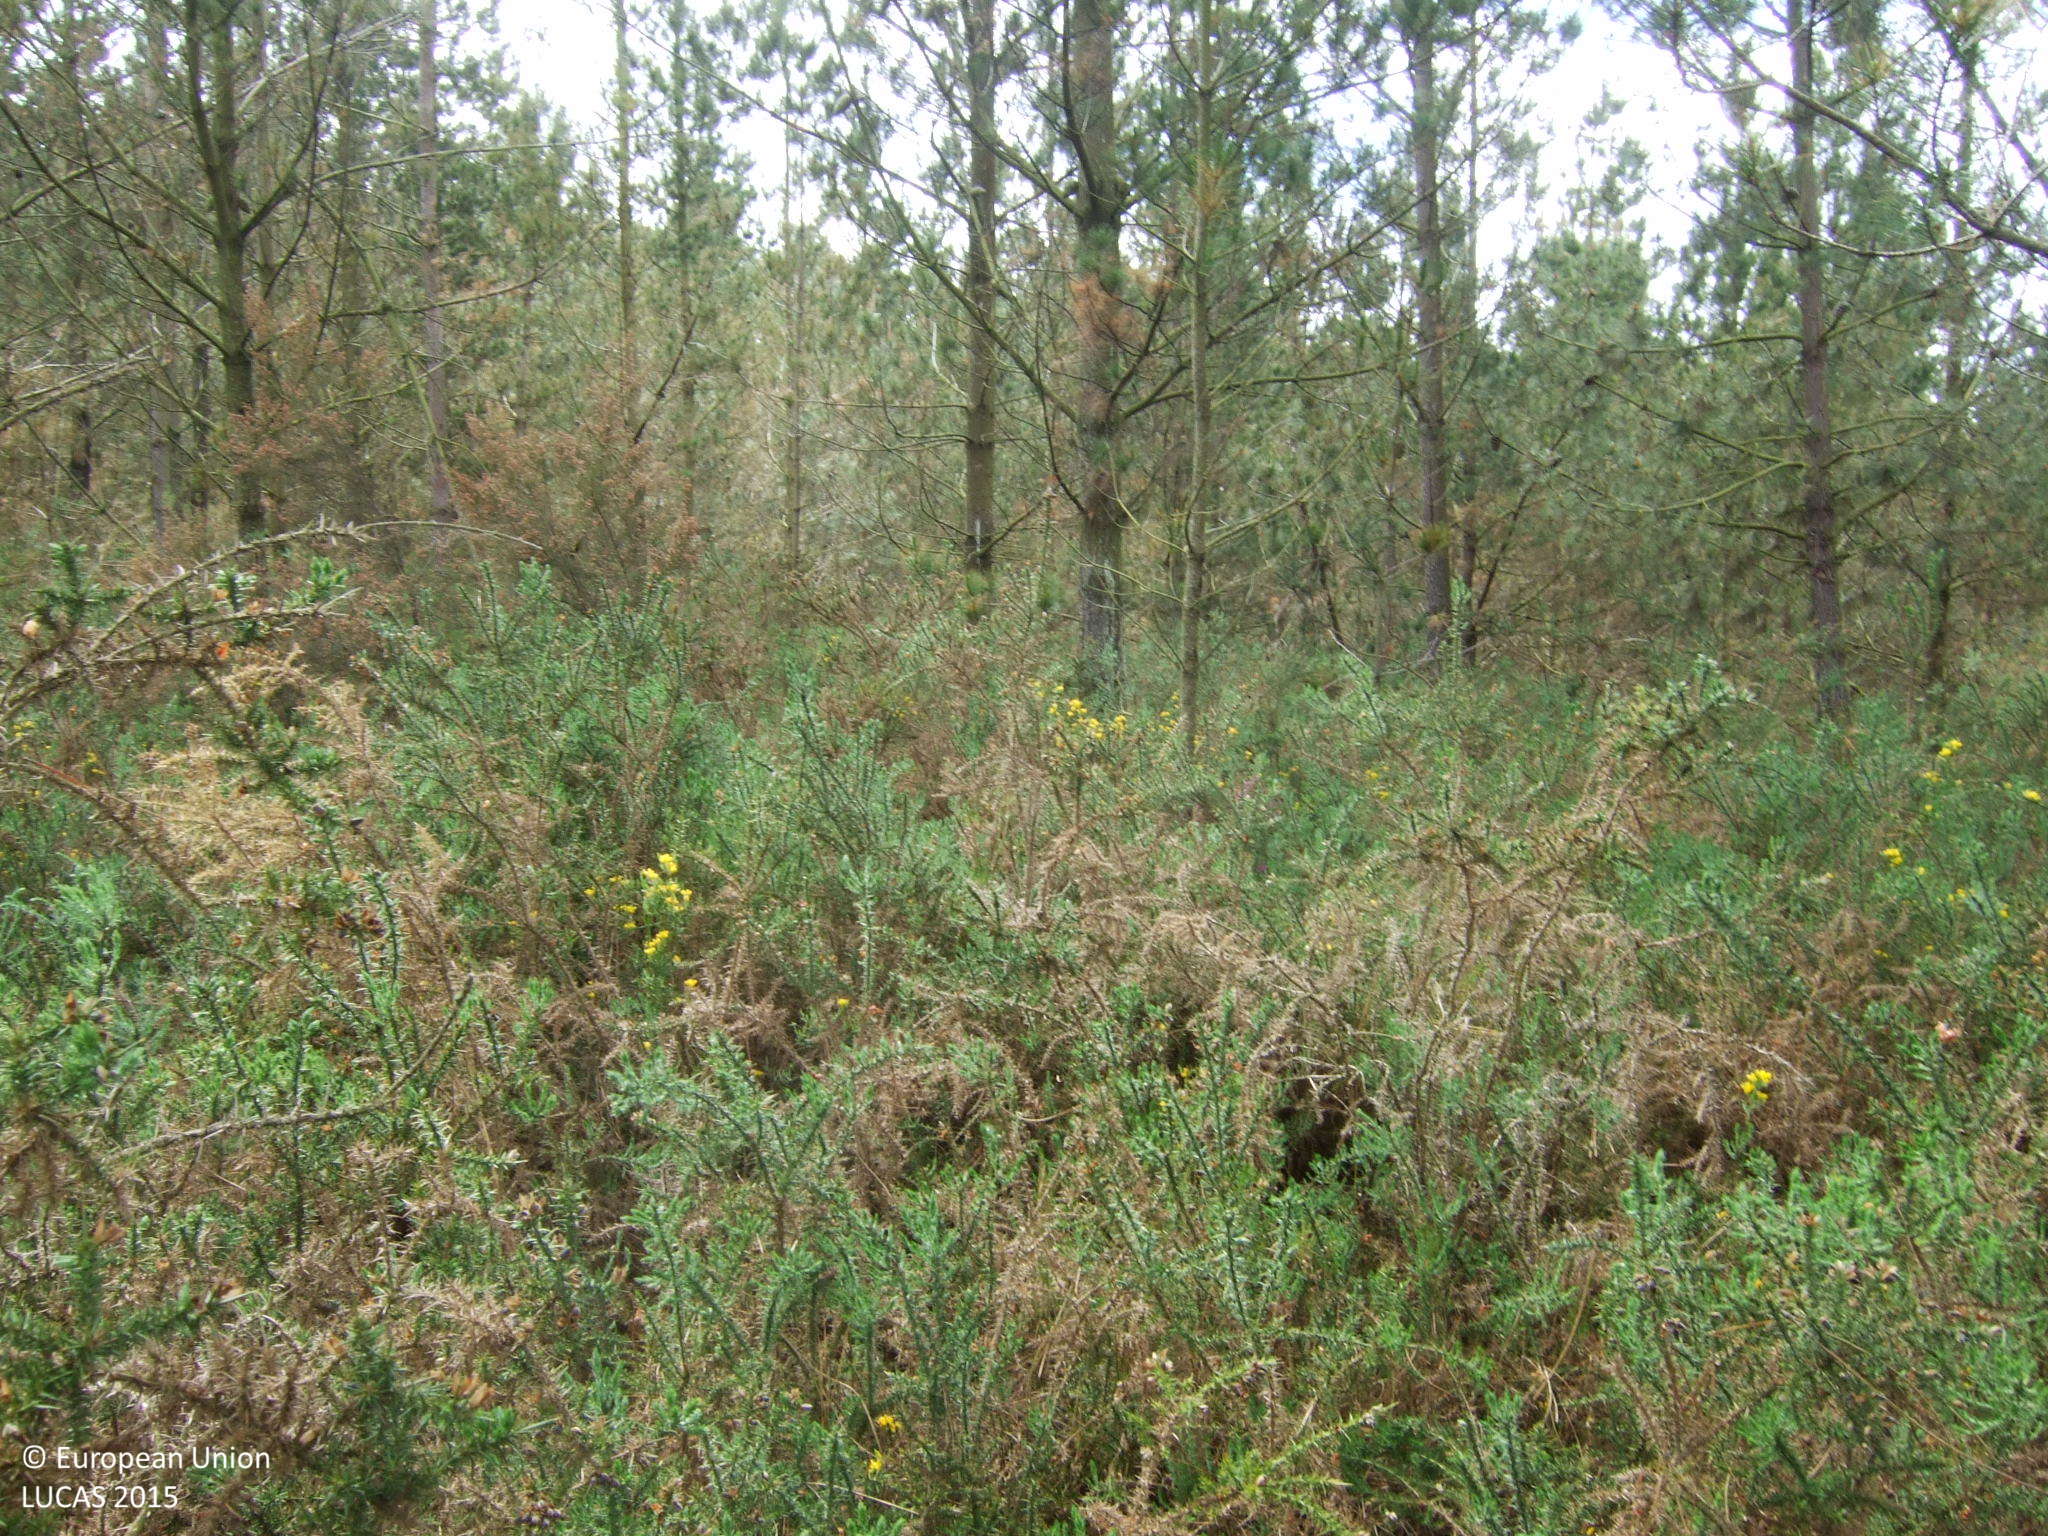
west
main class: Woodland
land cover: Pine dominated coniferous woodland
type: exotic forest
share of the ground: 25 - 50 %
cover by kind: shrubs 65 %, coniferous forest trees 35 %
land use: Forestry
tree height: > 5 m
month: May
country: ES
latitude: 43.1740
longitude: -7.4332
